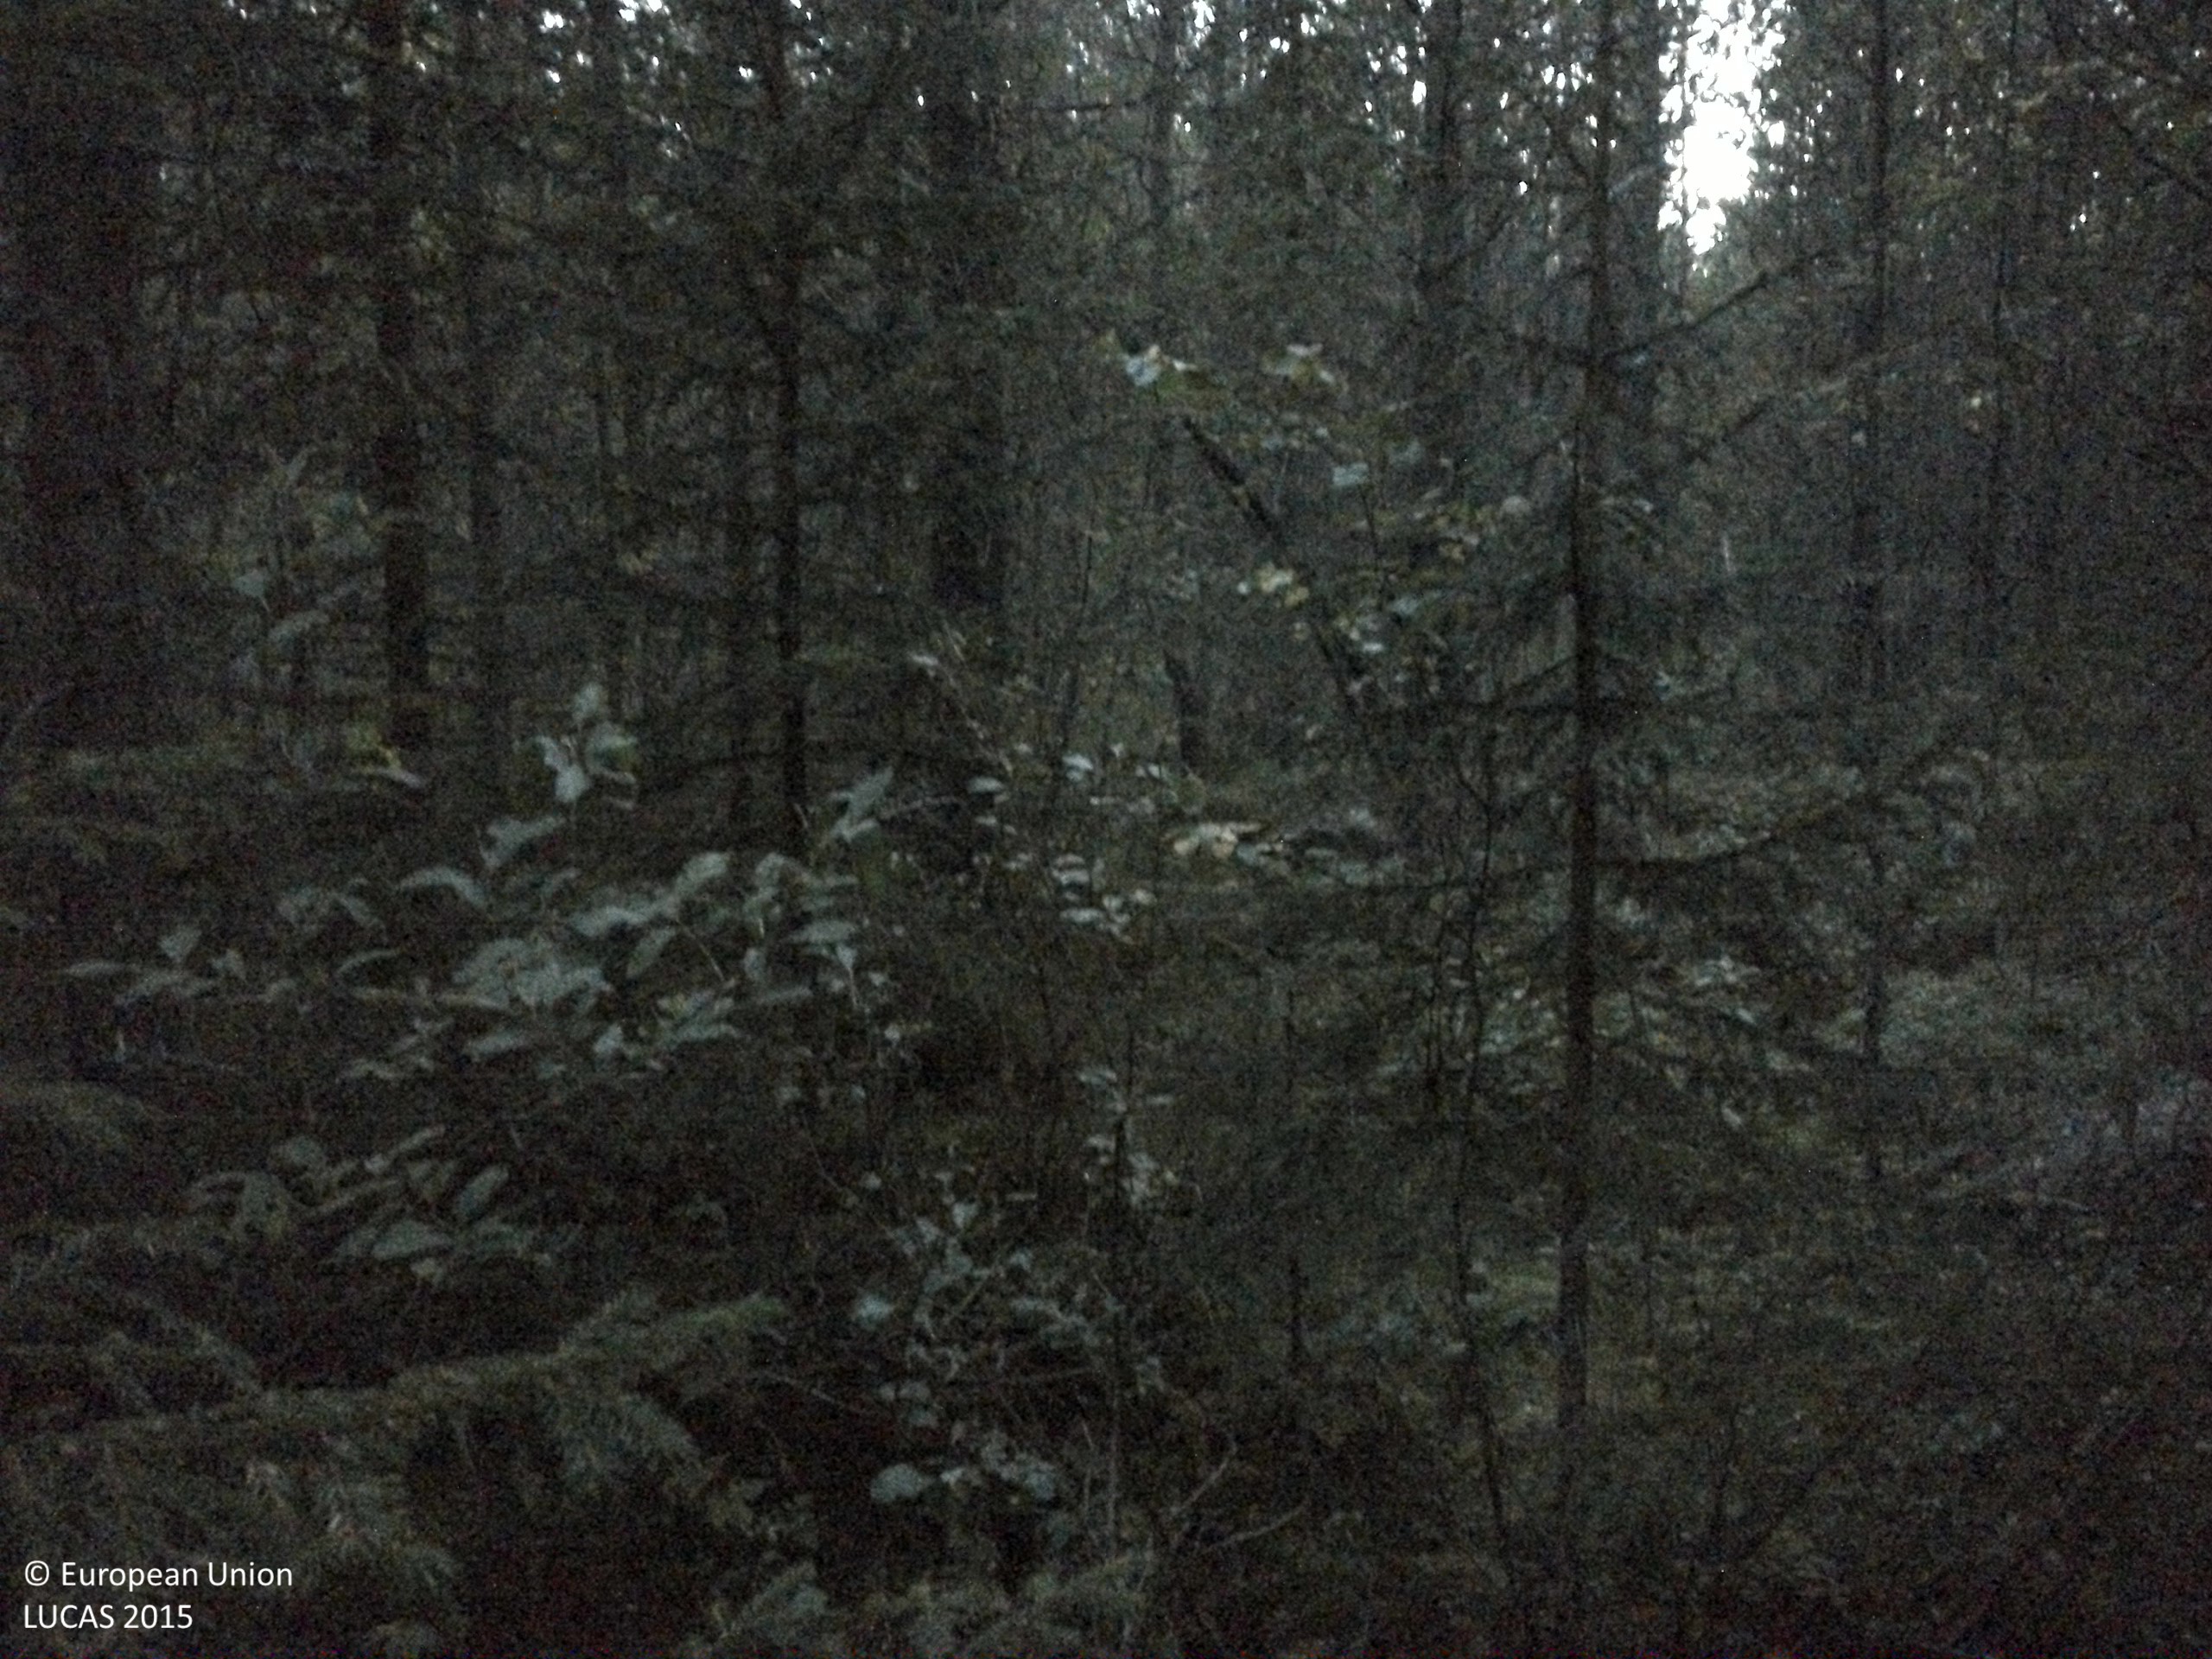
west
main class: Woodland
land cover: Pine dominated coniferous woodland
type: exotic forest
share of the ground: > 75 %
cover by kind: coniferous forest trees 70 %, broadleaved forest trees 10 %, shrubs 10 %, lichens and mosses 10 %
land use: Forestry
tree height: > 5 m
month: September
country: SE
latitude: 63.9149
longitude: 16.6368
